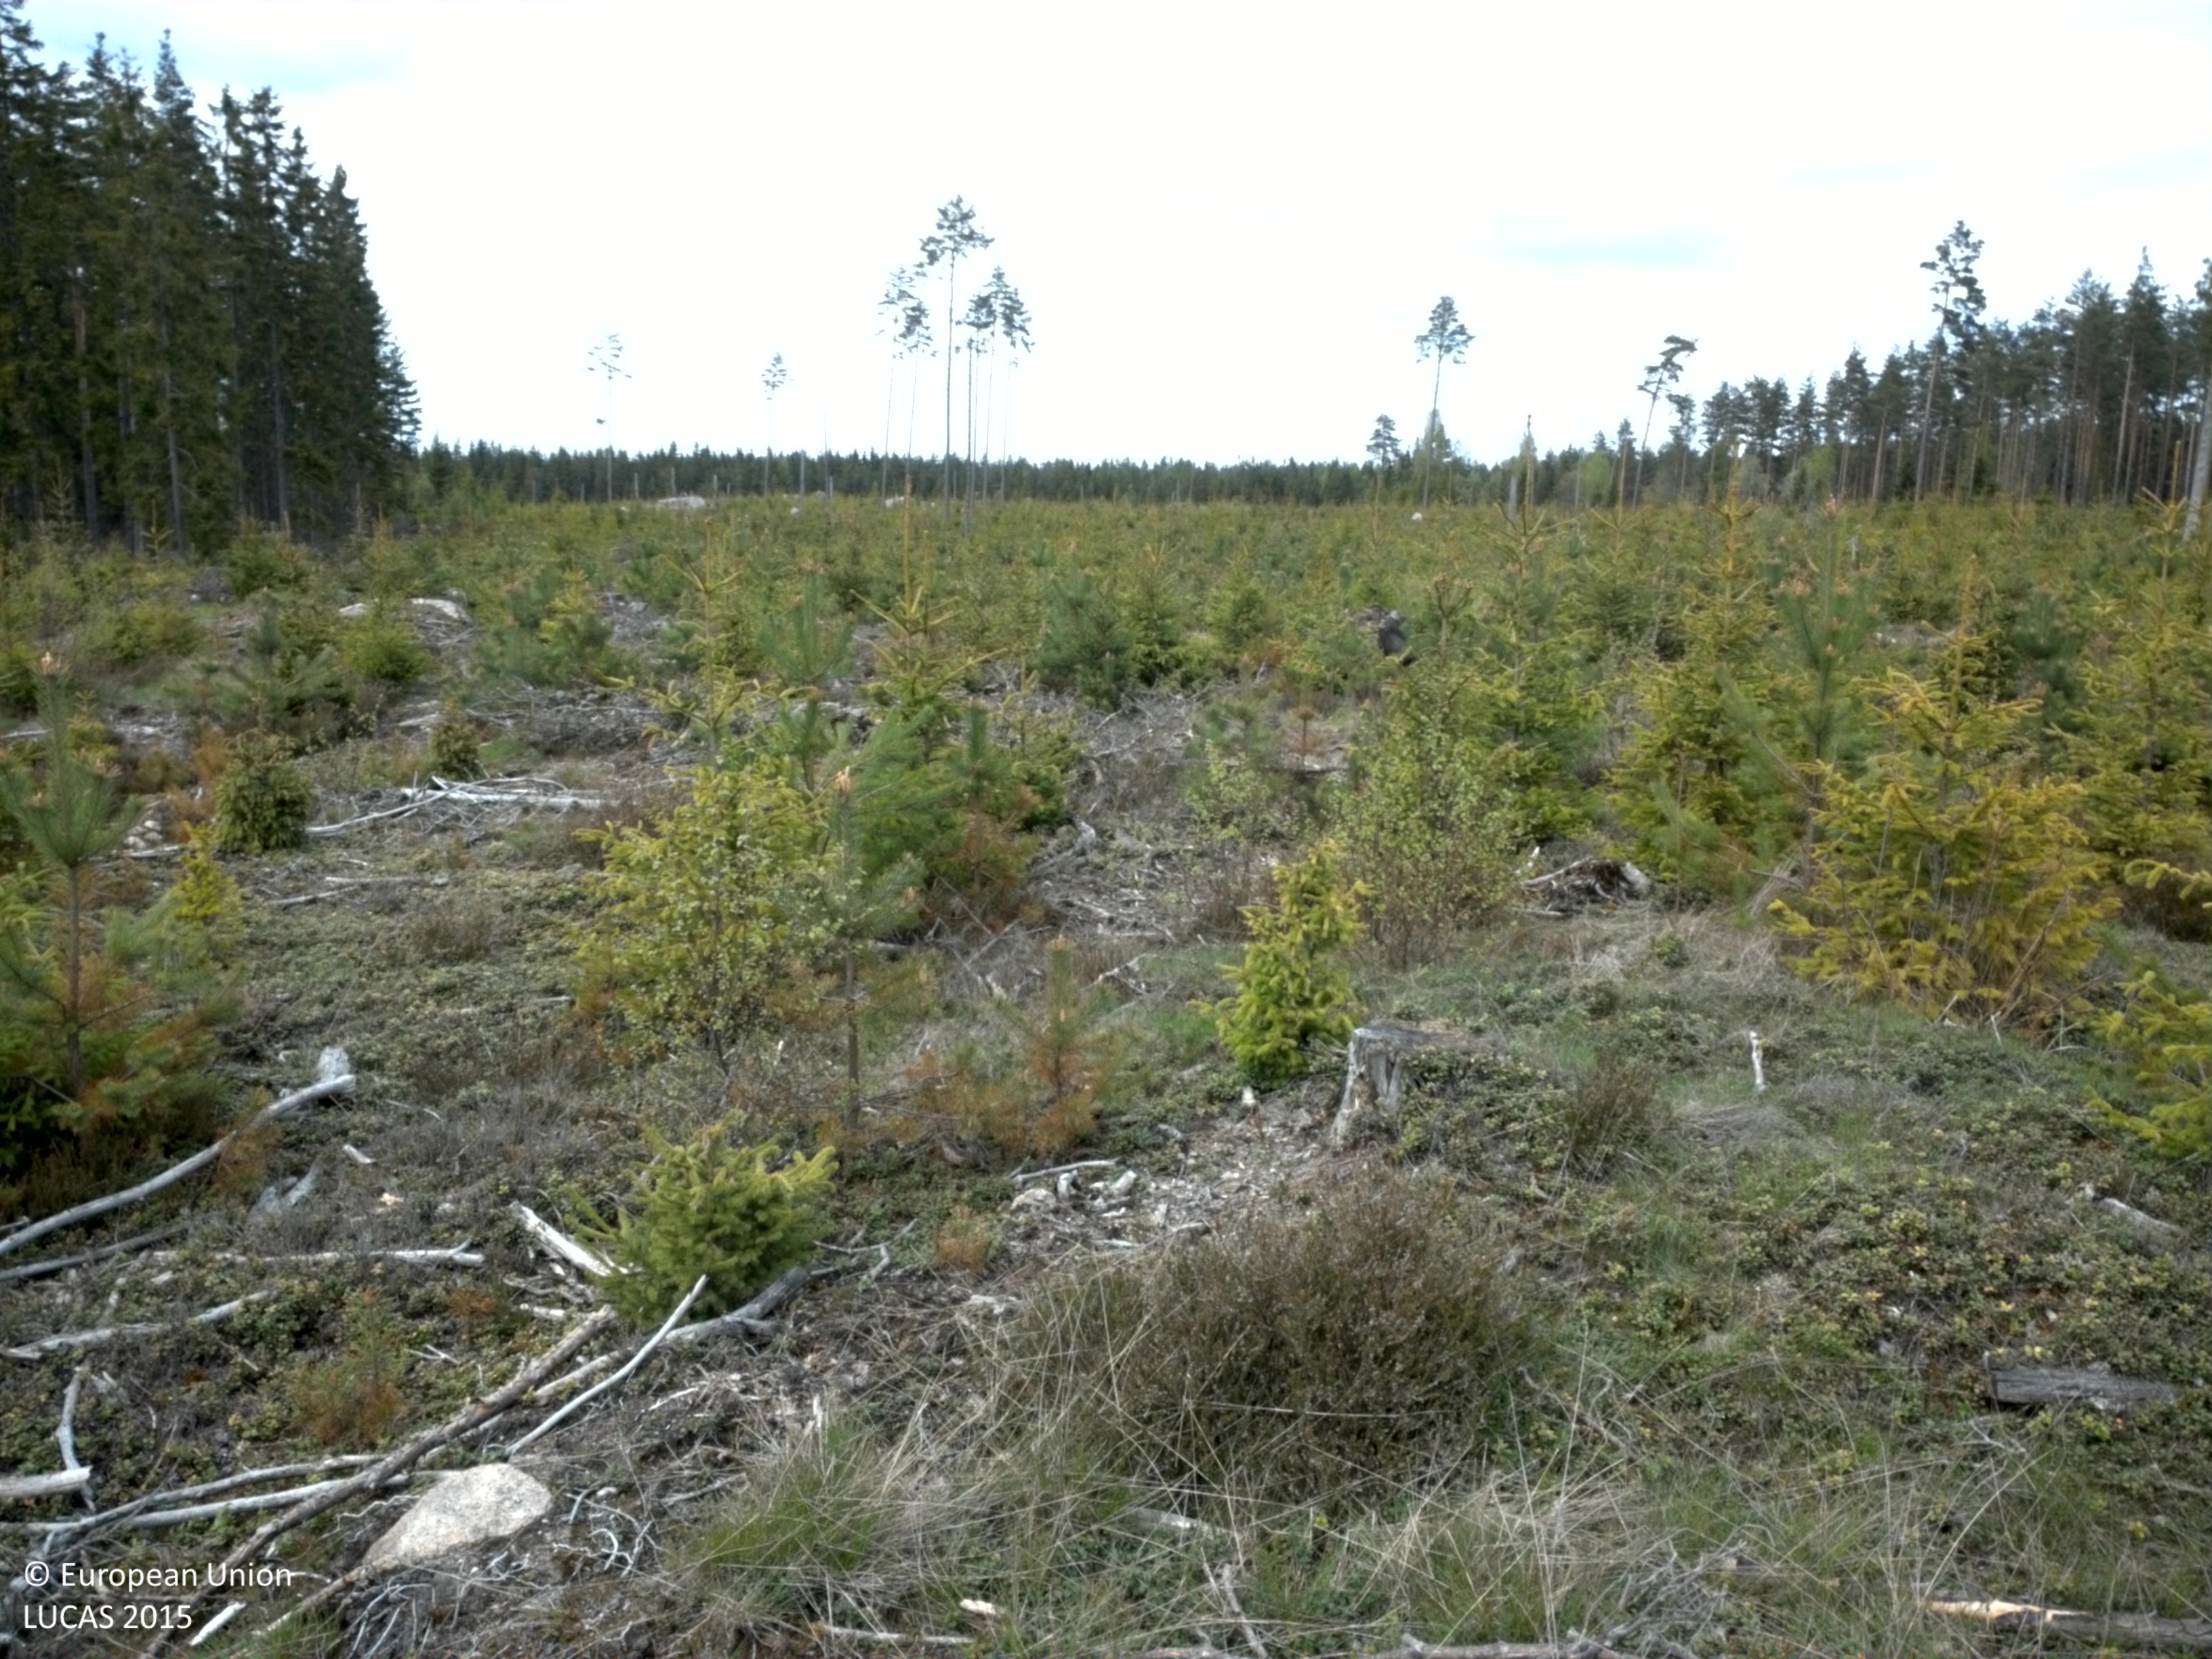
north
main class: Woodland
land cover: Other coniferous woodland
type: boreal forest
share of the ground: > 75 %
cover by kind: coniferous forest trees 90 %, shrubs 5 %, lichens and mosses 5 %
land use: Forestry
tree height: < 5 m
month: May
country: SE
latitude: 56.7764
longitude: 15.4150
